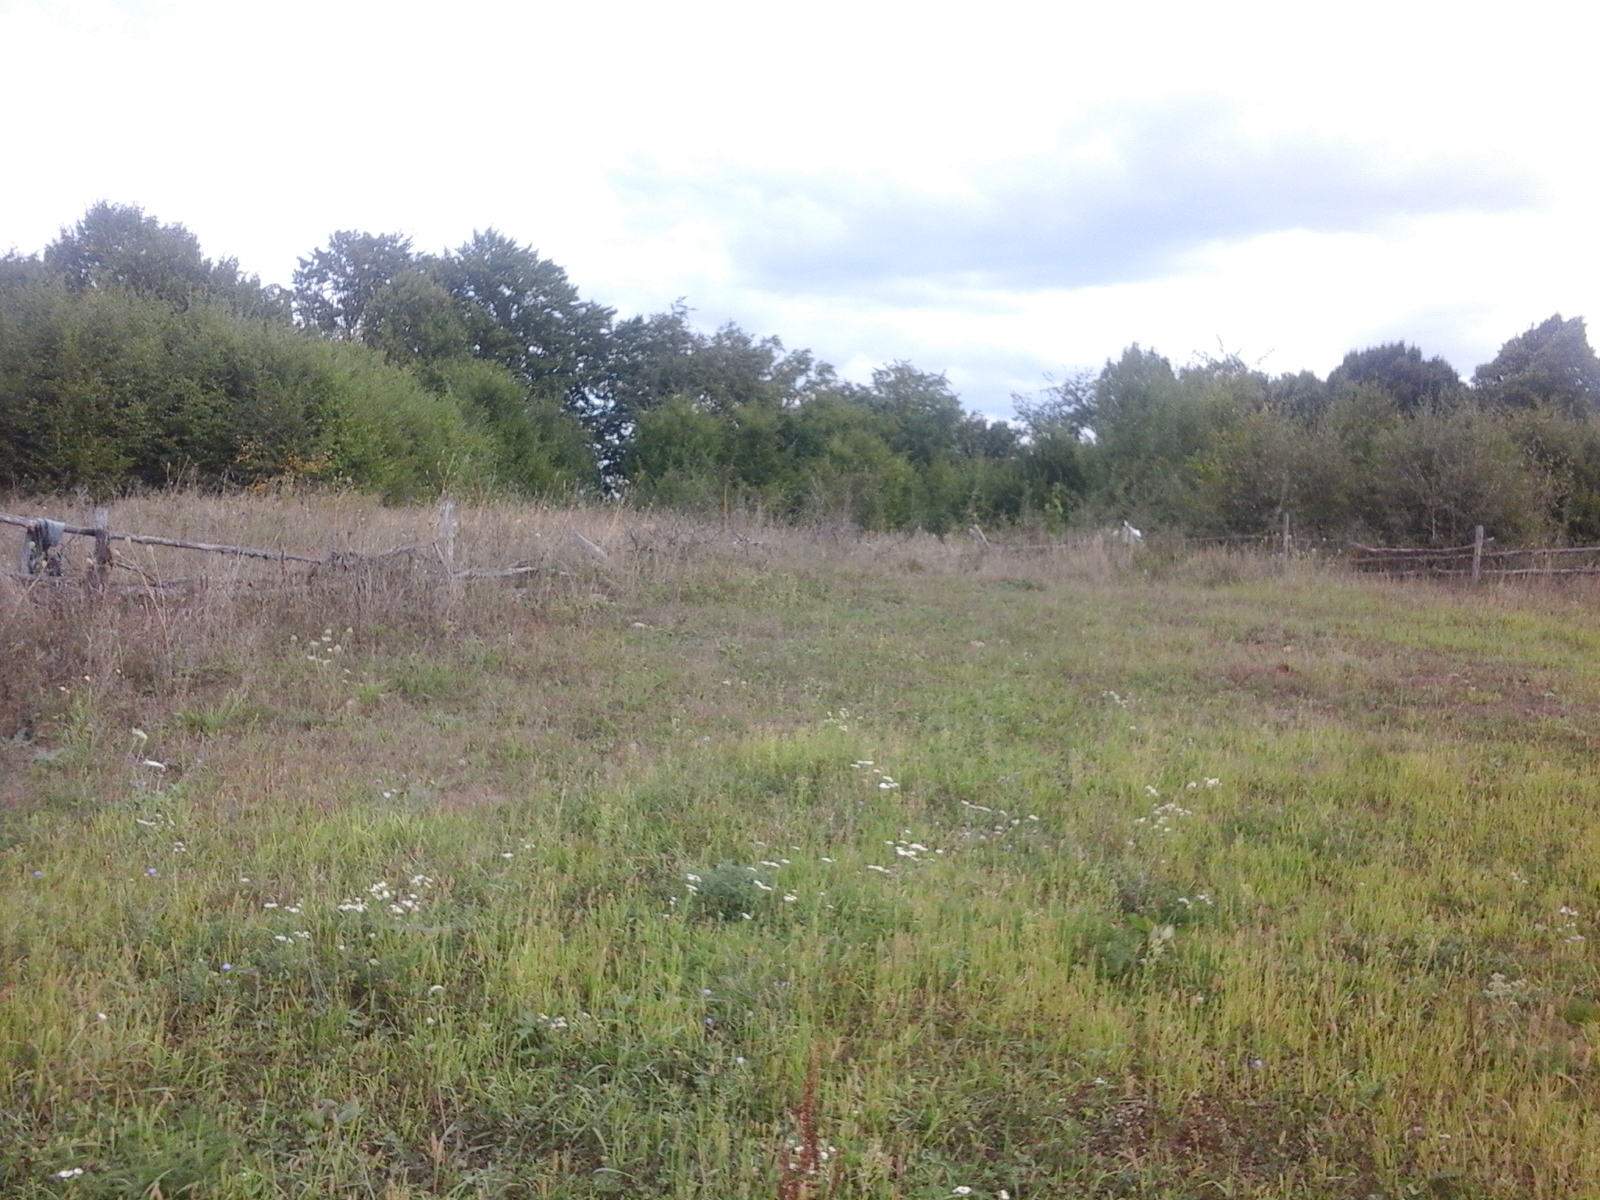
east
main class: Grassland
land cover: Grassland without tree/shrub cover
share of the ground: > 75 %
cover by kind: herbaceous plants 100 %
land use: Agriculture (excluding fallow land and kitchen gardens)
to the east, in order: Grassland without tree/shrub cover; Fences; Grassland without tree/shrub cover; Broadleaved woodland; Grassland without tree/shrub cover; Abandoned hedges; Grassland without tree/shrub cover; Broadleaved woodland
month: September
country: RO
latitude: 47.4303
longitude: 23.7466
